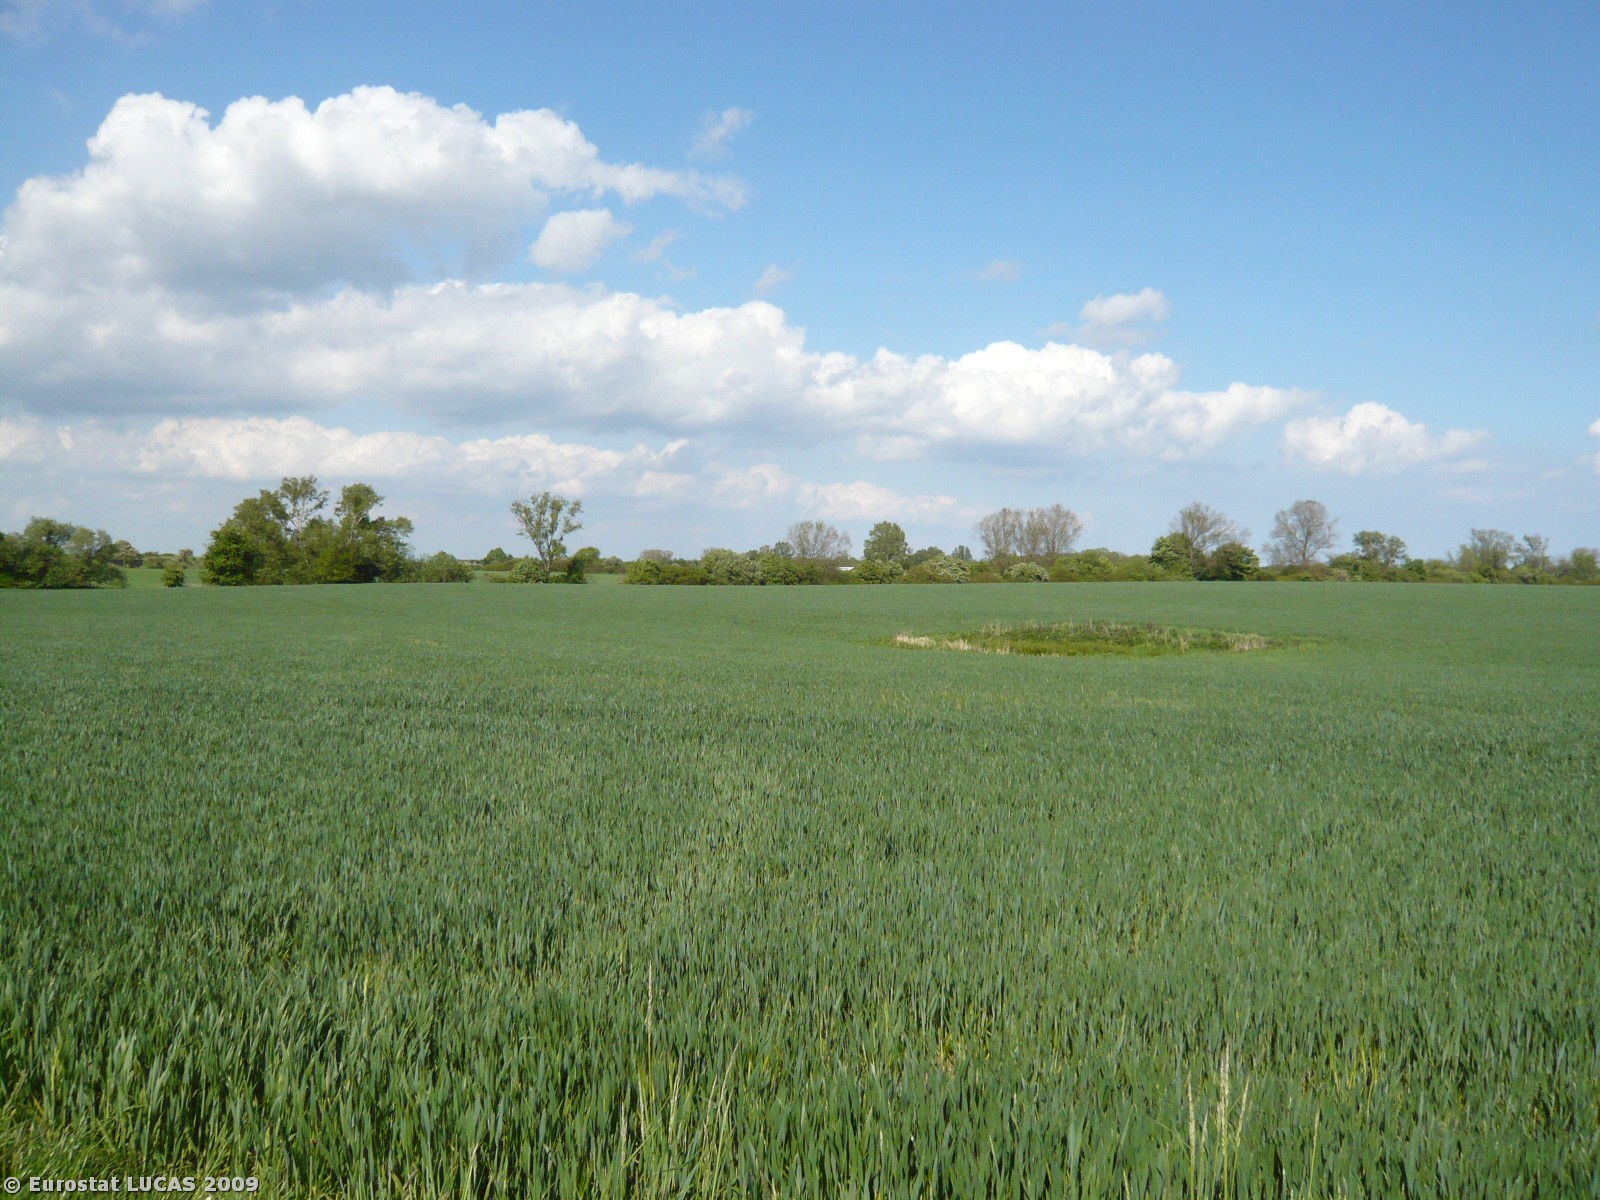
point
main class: Cropland
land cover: Common wheat
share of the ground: > 75 %
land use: Agriculture (excluding fallow land and kitchen gardens)
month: May
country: DK
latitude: 55.4143
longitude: 12.1624
